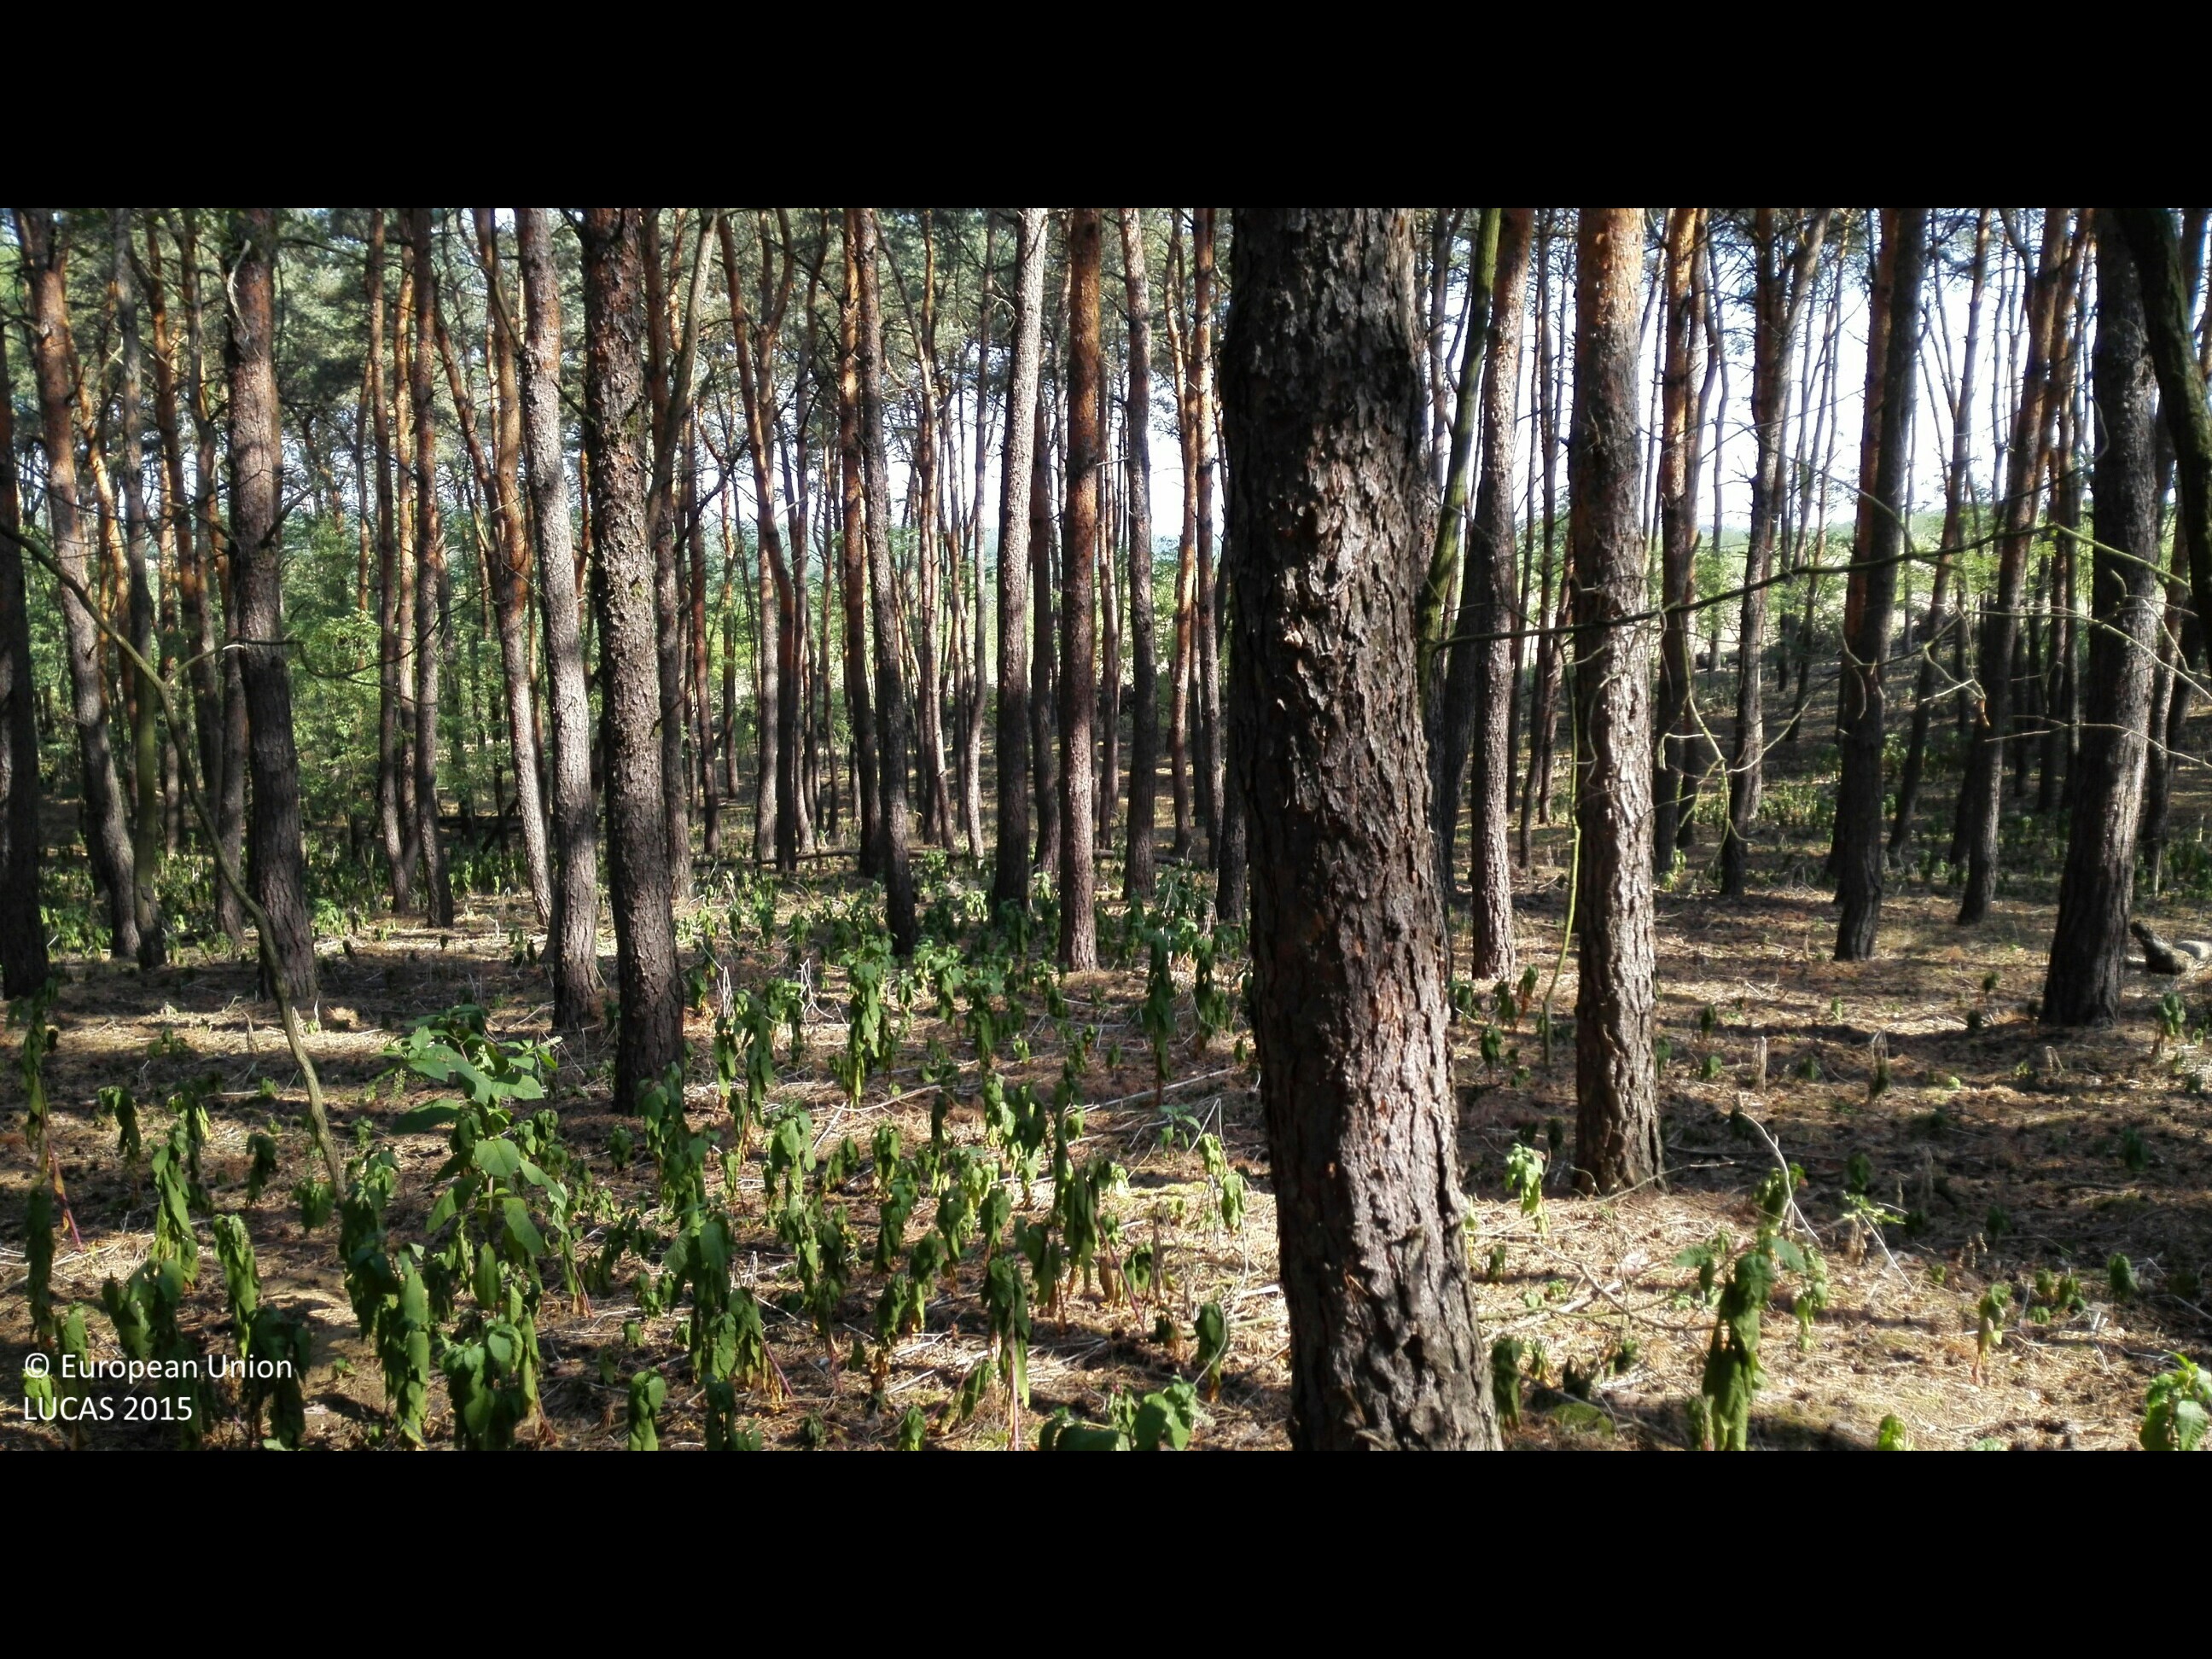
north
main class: Woodland
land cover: Pine dominated mixed woodland
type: hemiboreal forest and nemoral coniferous forest and mixed broadleaved-coniferous forest
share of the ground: > 75 %
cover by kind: coniferous forest trees 75 %, broadleaved forest trees 25 %
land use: Forestry
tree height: > 5 m
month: August
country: HU
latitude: 47.5947
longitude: 21.8981
